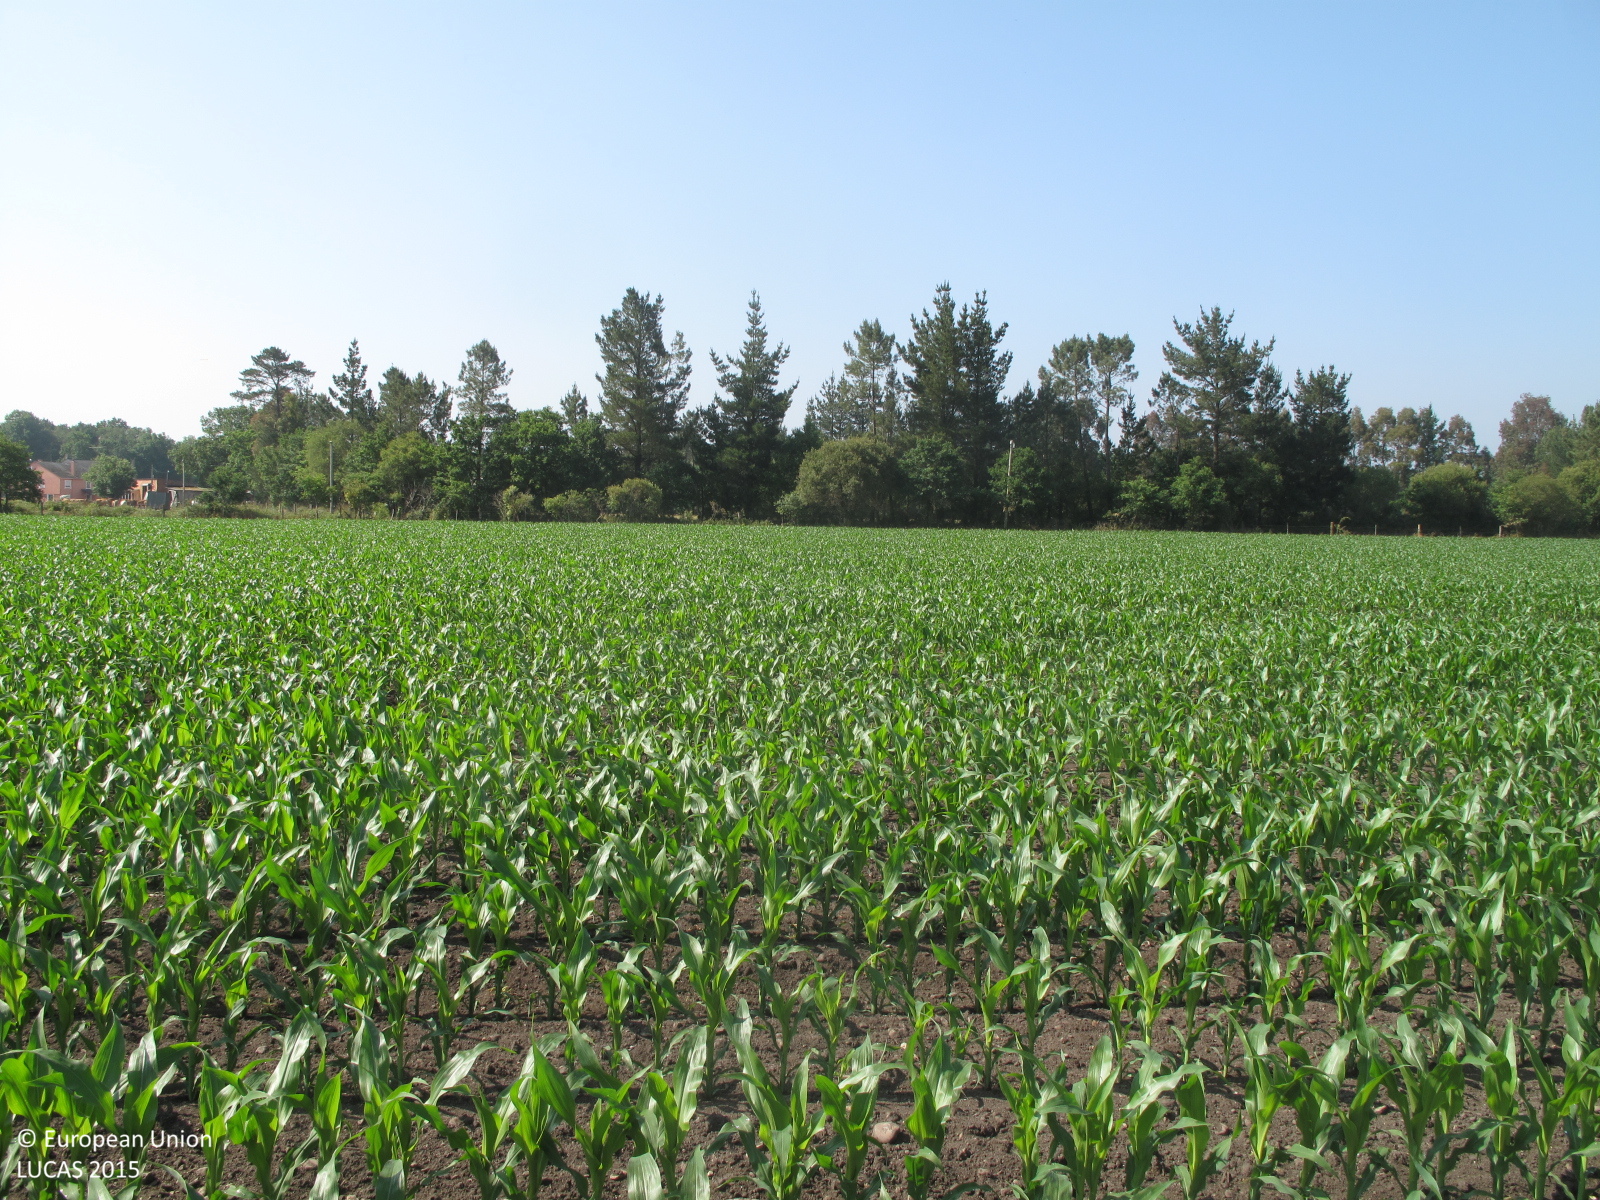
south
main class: Cropland
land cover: Maize
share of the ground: 25 - 50 %
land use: Agriculture (excluding fallow land and kitchen gardens)
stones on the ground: < 10 %
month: June
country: ES
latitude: 43.1680
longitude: -7.8872
